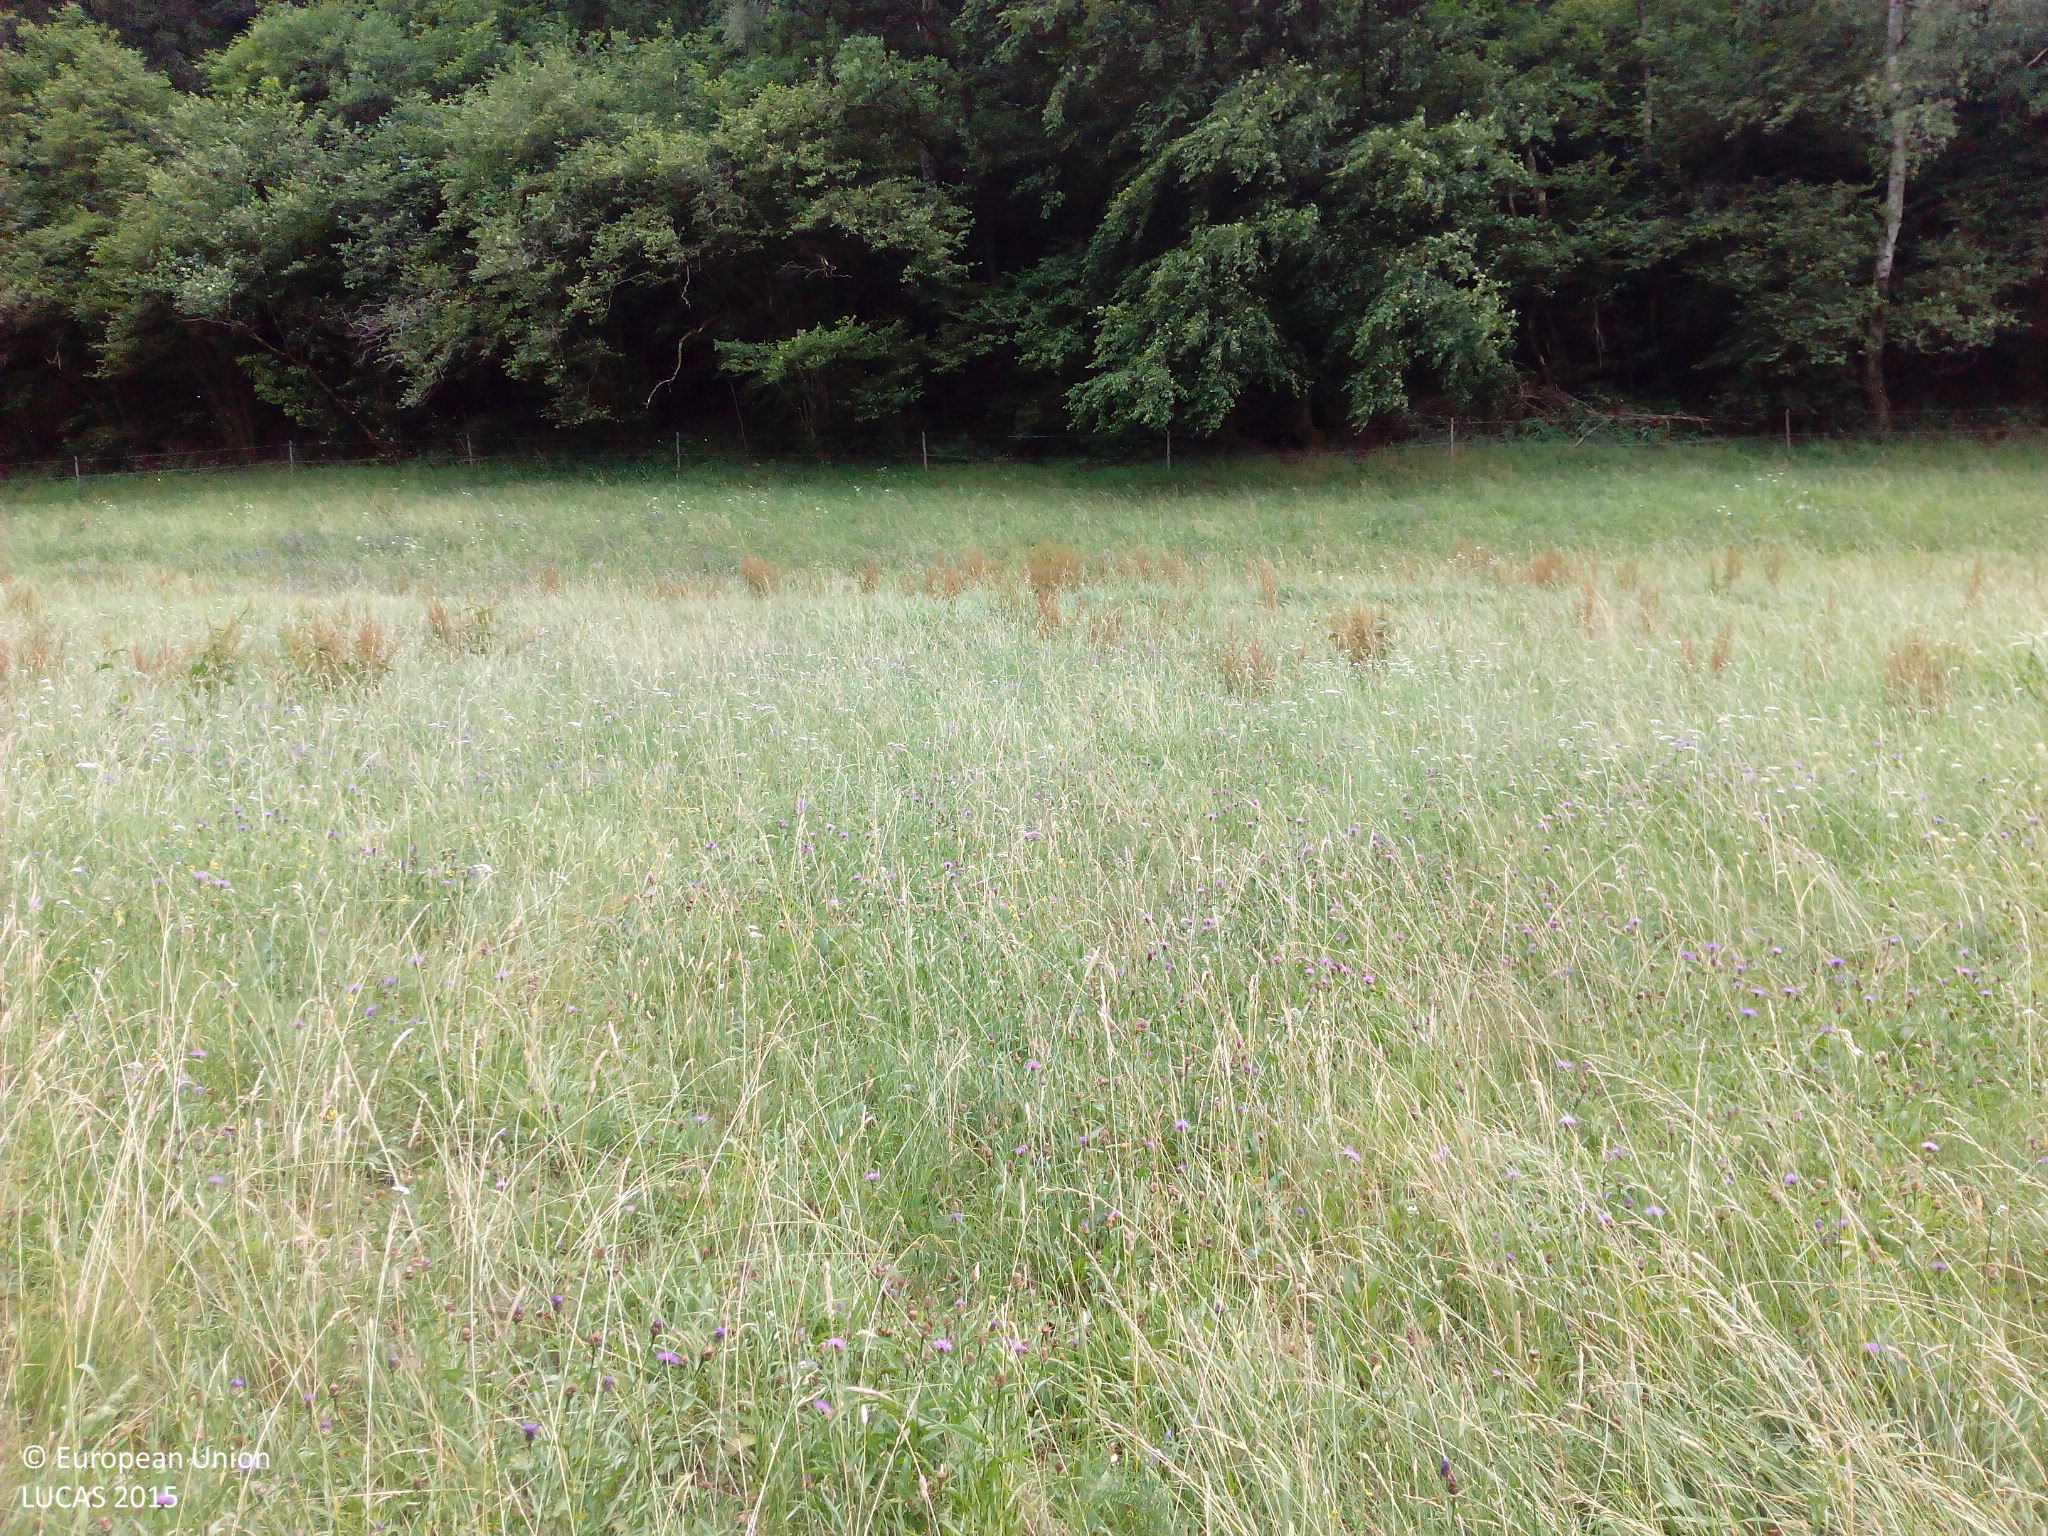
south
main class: Grassland
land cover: Grassland without tree/shrub cover
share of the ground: > 75 %
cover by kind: herbaceous plants 100 %
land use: Agriculture (excluding fallow land and kitchen gardens)
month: July
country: DE
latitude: 49.5531
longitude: 7.0836
